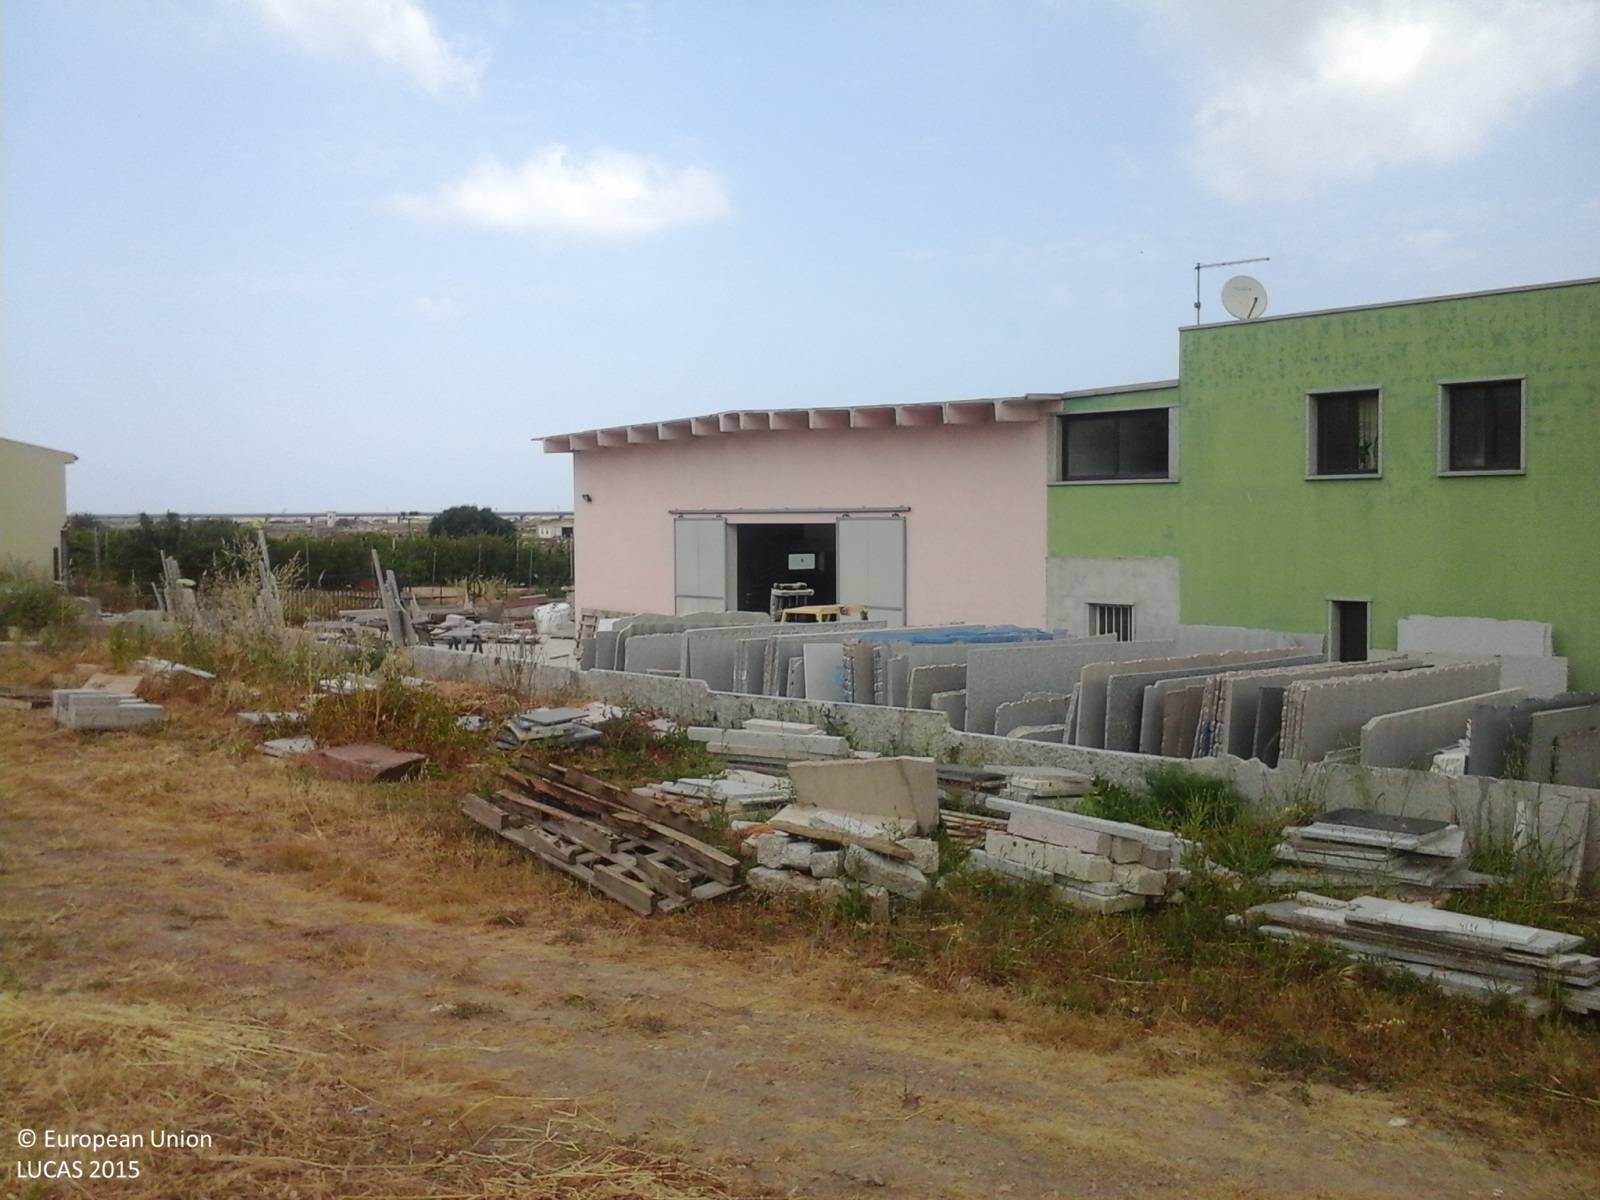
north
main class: Grassland
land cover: Grassland without tree/shrub cover
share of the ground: > 75 %
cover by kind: herbaceous plants 95 %, shrubs 5 %
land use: Semi-natural and natural areas not in use
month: May
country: IT
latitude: 40.9122
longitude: 8.8537
